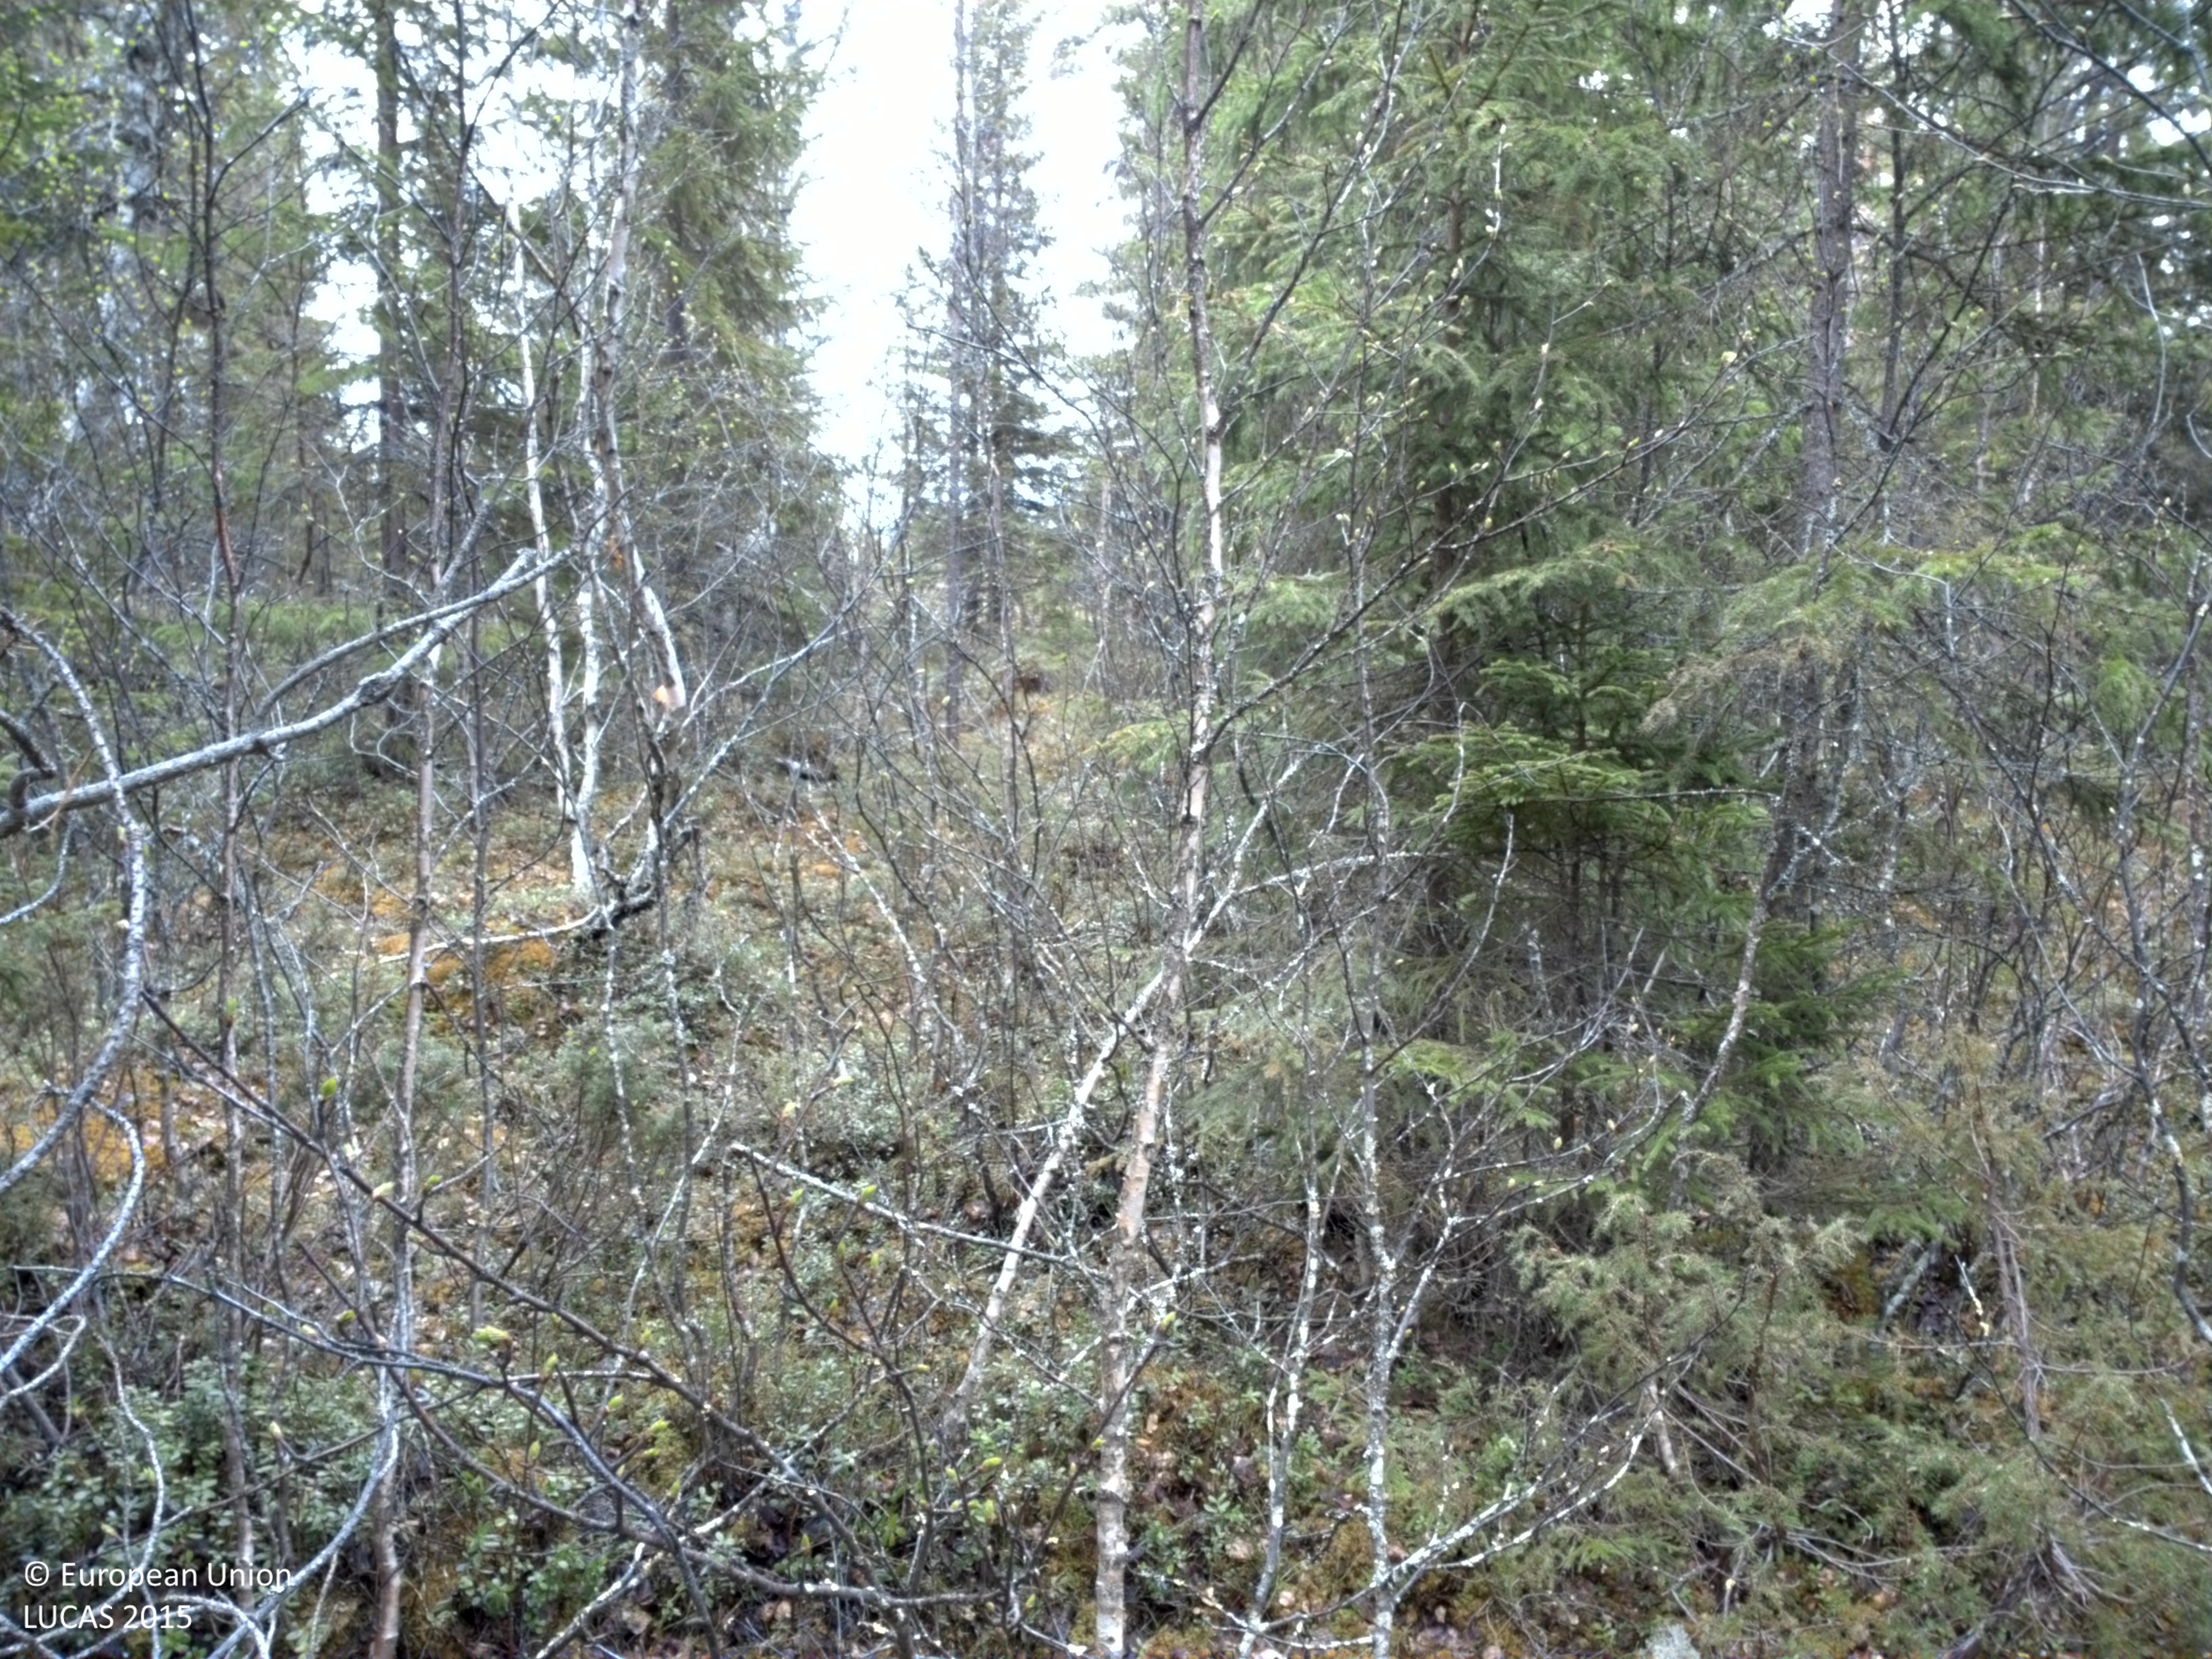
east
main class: Woodland
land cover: Spruce dominated mixed woodland
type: boreal forest
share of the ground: > 75 %
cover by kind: coniferous forest trees 55 %, broadleaved forest trees 25 %, shrubs 20 %
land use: Forestry
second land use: Amenities, museums, leisure
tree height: > 5 m
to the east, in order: Spruce dominated mixed woodland; Grassland with sparse tree/shrub cover; Spruce dominated mixed woodland; Inland marshes; Spruce dominated coniferous woodland; Broadleaved woodland
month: June
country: SE
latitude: 63.6431
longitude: 14.6404
